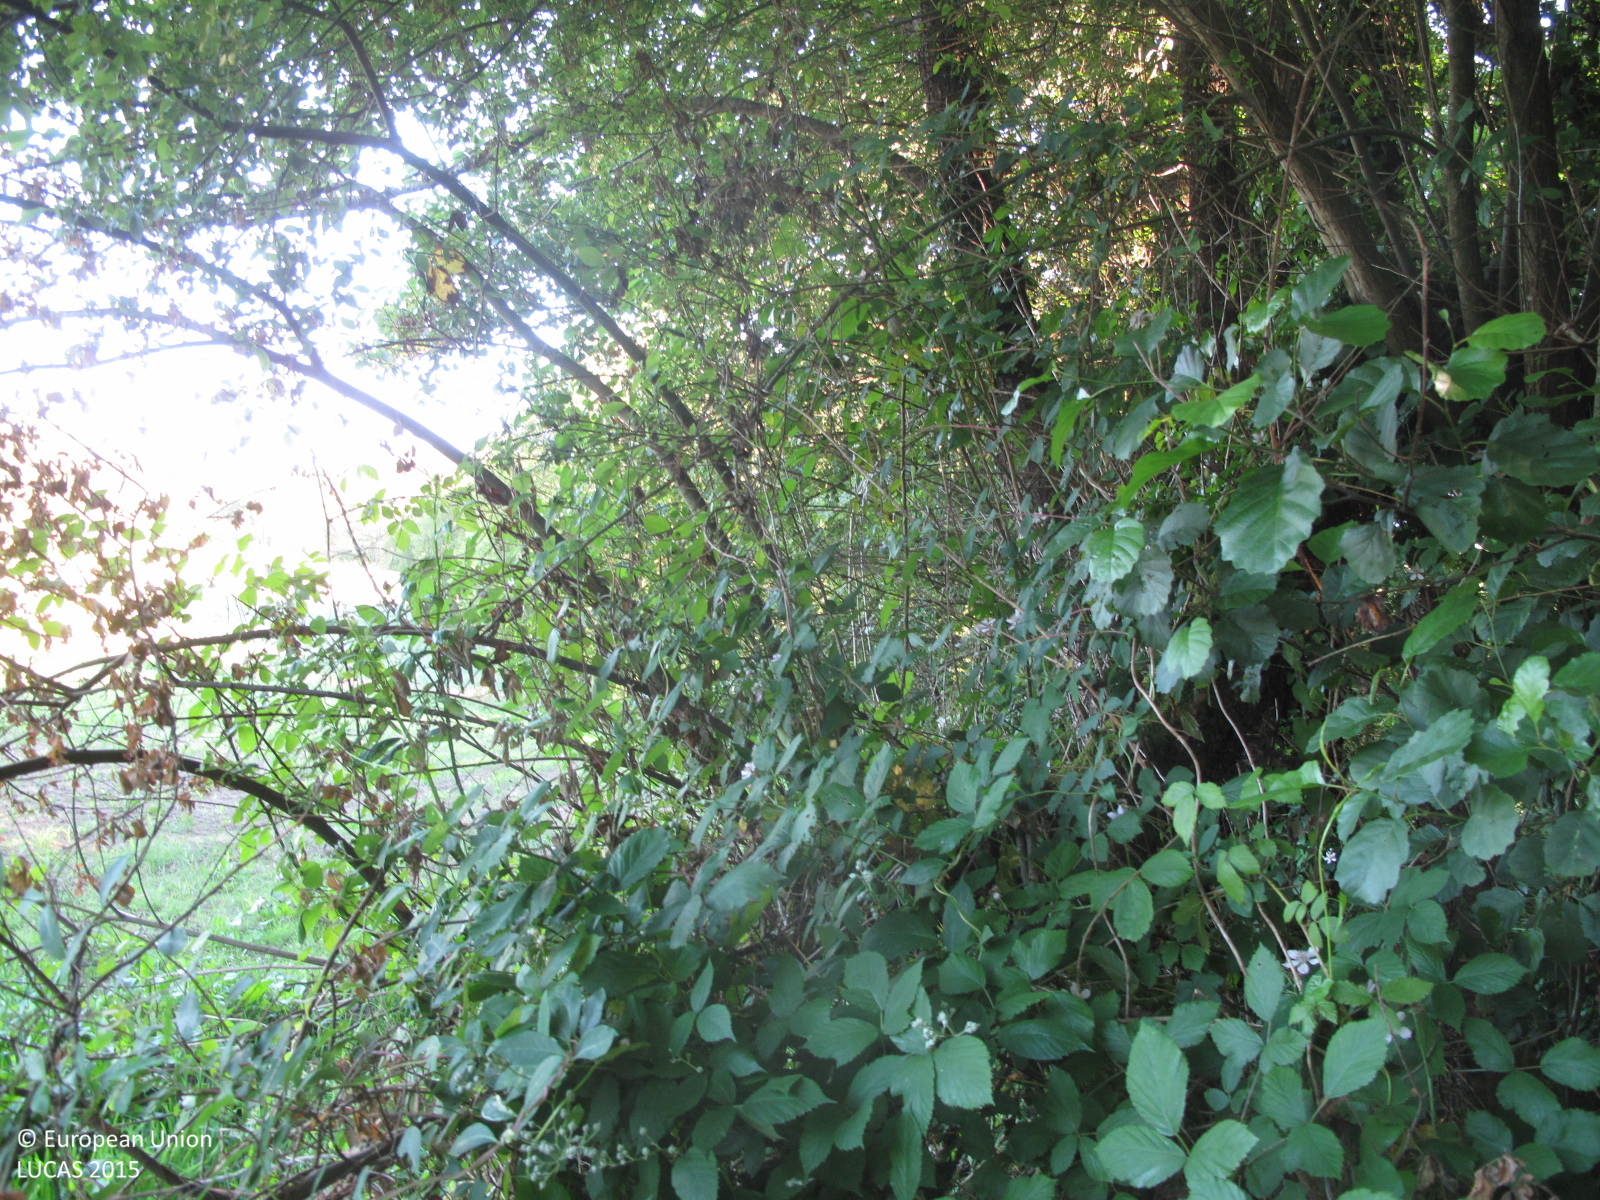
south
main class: Woodland
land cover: Broadleaved woodland
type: non-riverine alder, birch or aspen forest
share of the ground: > 75 %
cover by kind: broadleaved forest trees 90 %, shrubs 10 %
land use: Forestry
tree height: > 5 m
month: June
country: ES
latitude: 43.0069
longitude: -8.5708
